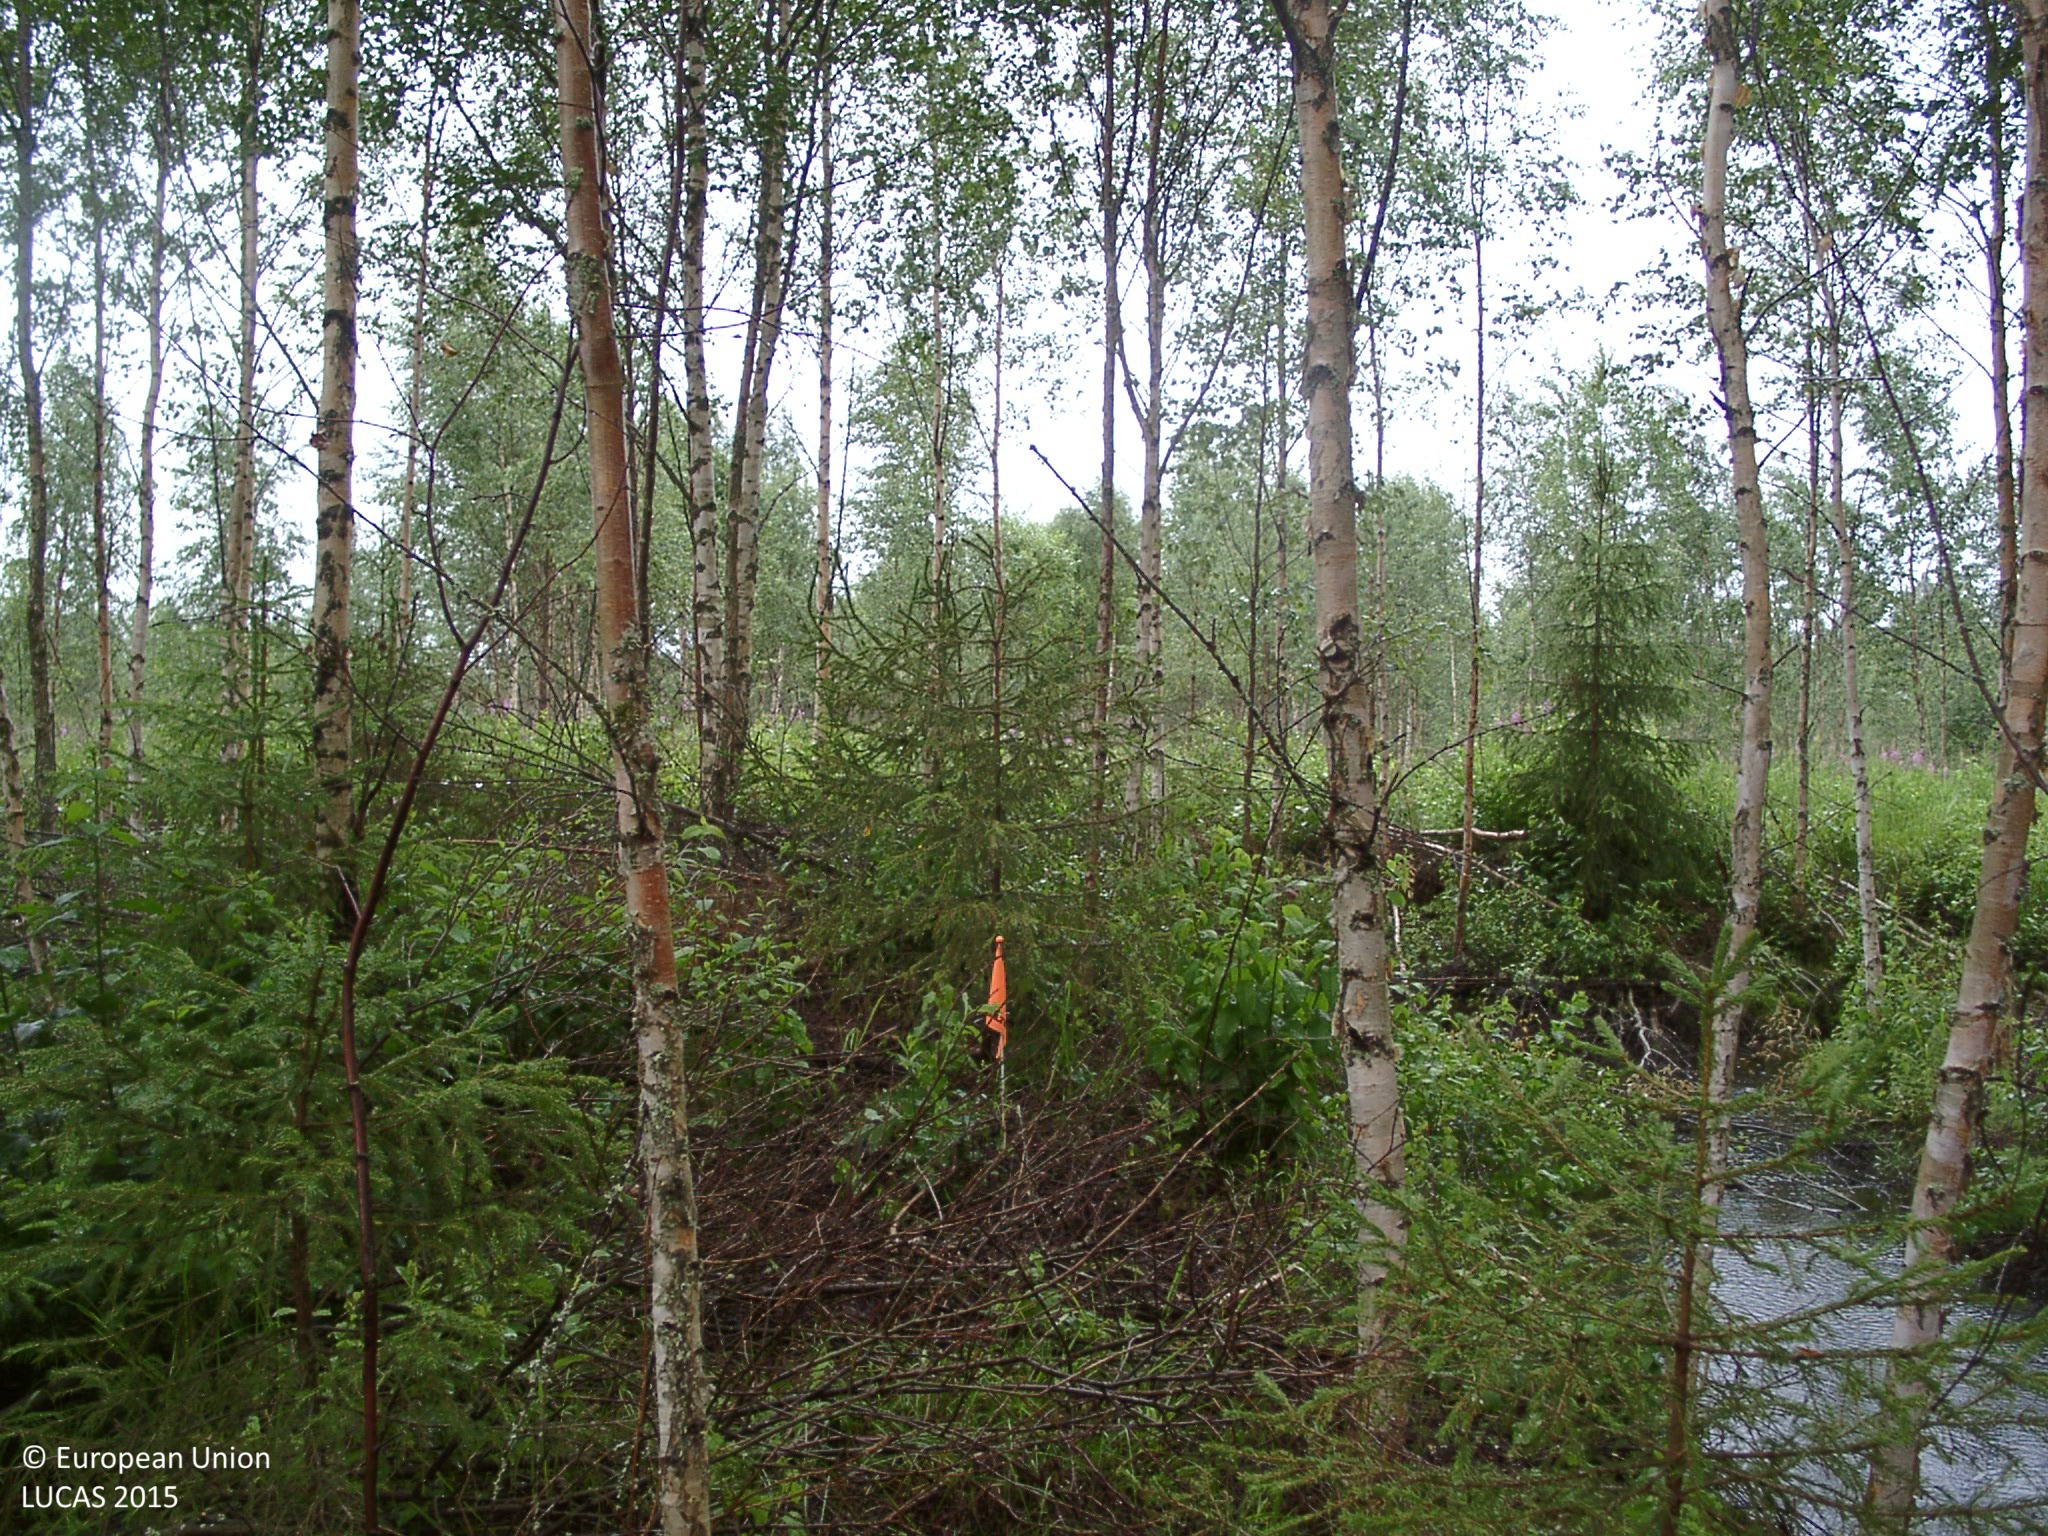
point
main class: Woodland
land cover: Broadleaved woodland
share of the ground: 50 - 75 %
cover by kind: broadleaved forest trees 55 %, coniferous forest trees 15 %, shrubs 5 %, herbaceous plants 5 %
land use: Forestry
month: August
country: FI
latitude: 62.8202
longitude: 24.5499
